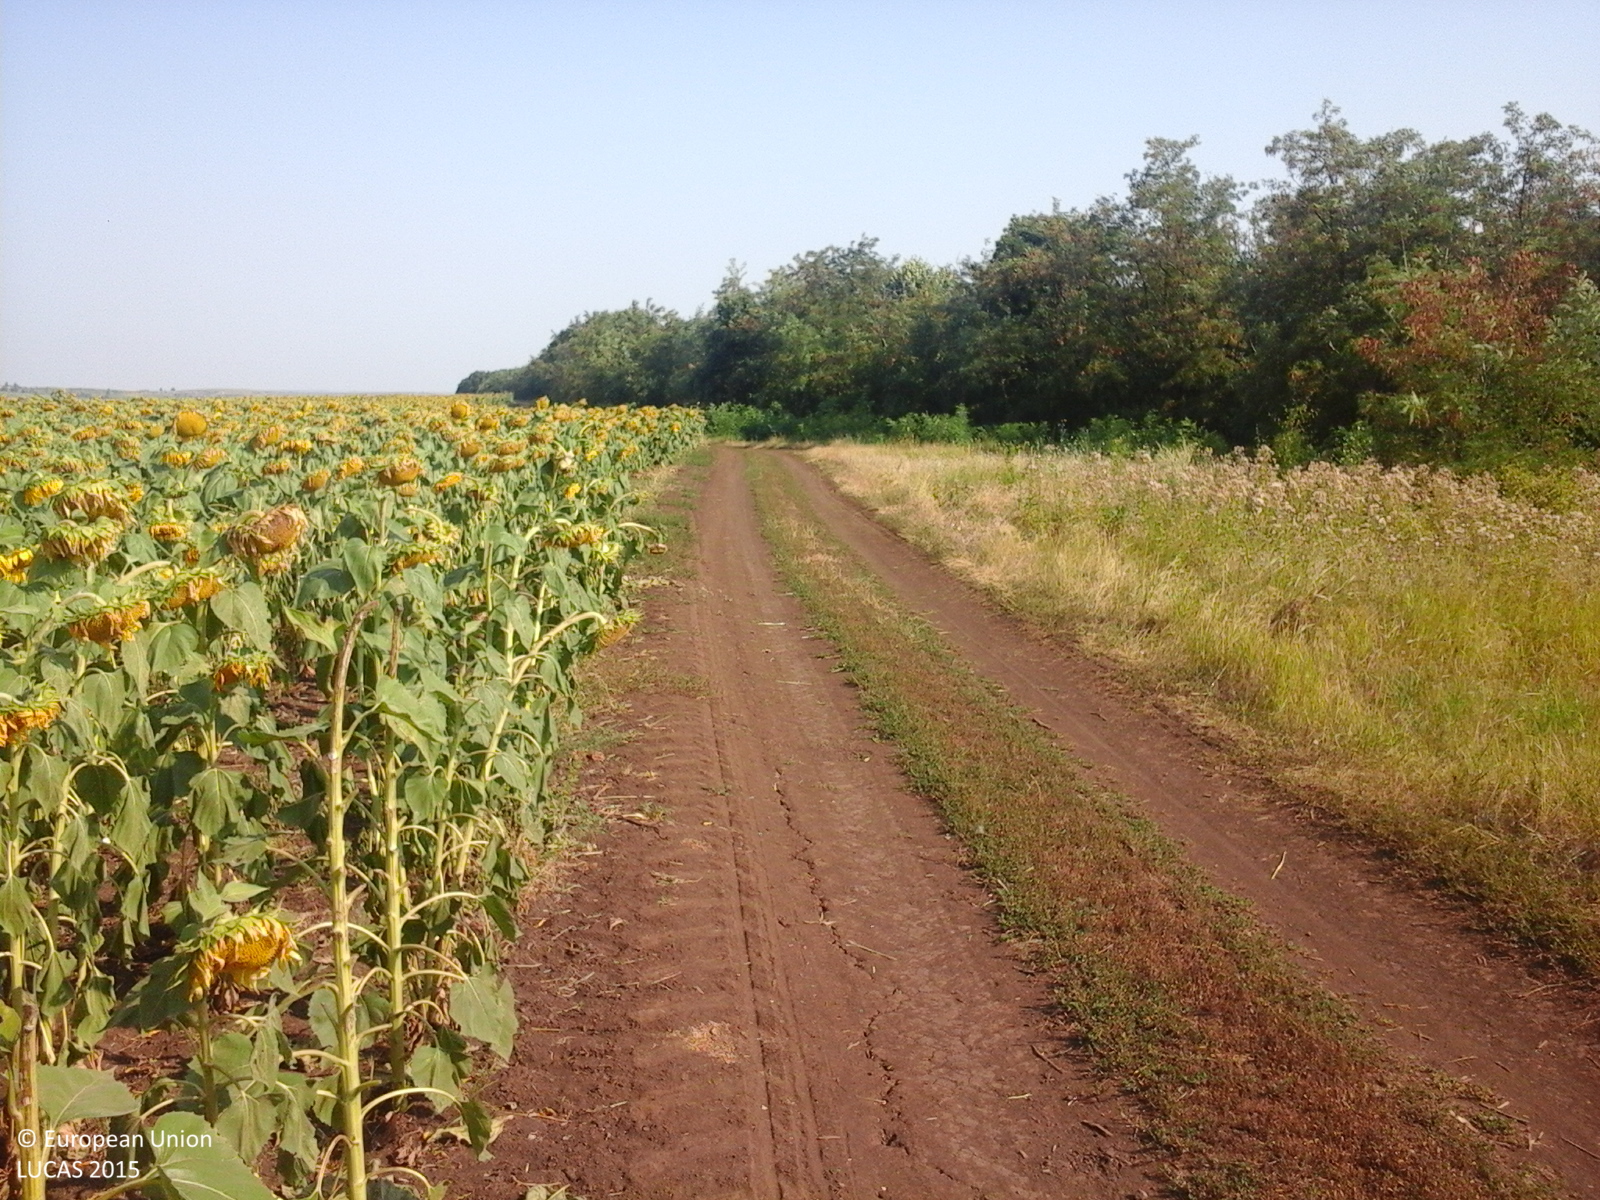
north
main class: Cropland
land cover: Sunflower
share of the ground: > 75 %
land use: Agriculture (excluding fallow land and kitchen gardens)
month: July
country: RO
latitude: 45.9657
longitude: 28.0211
